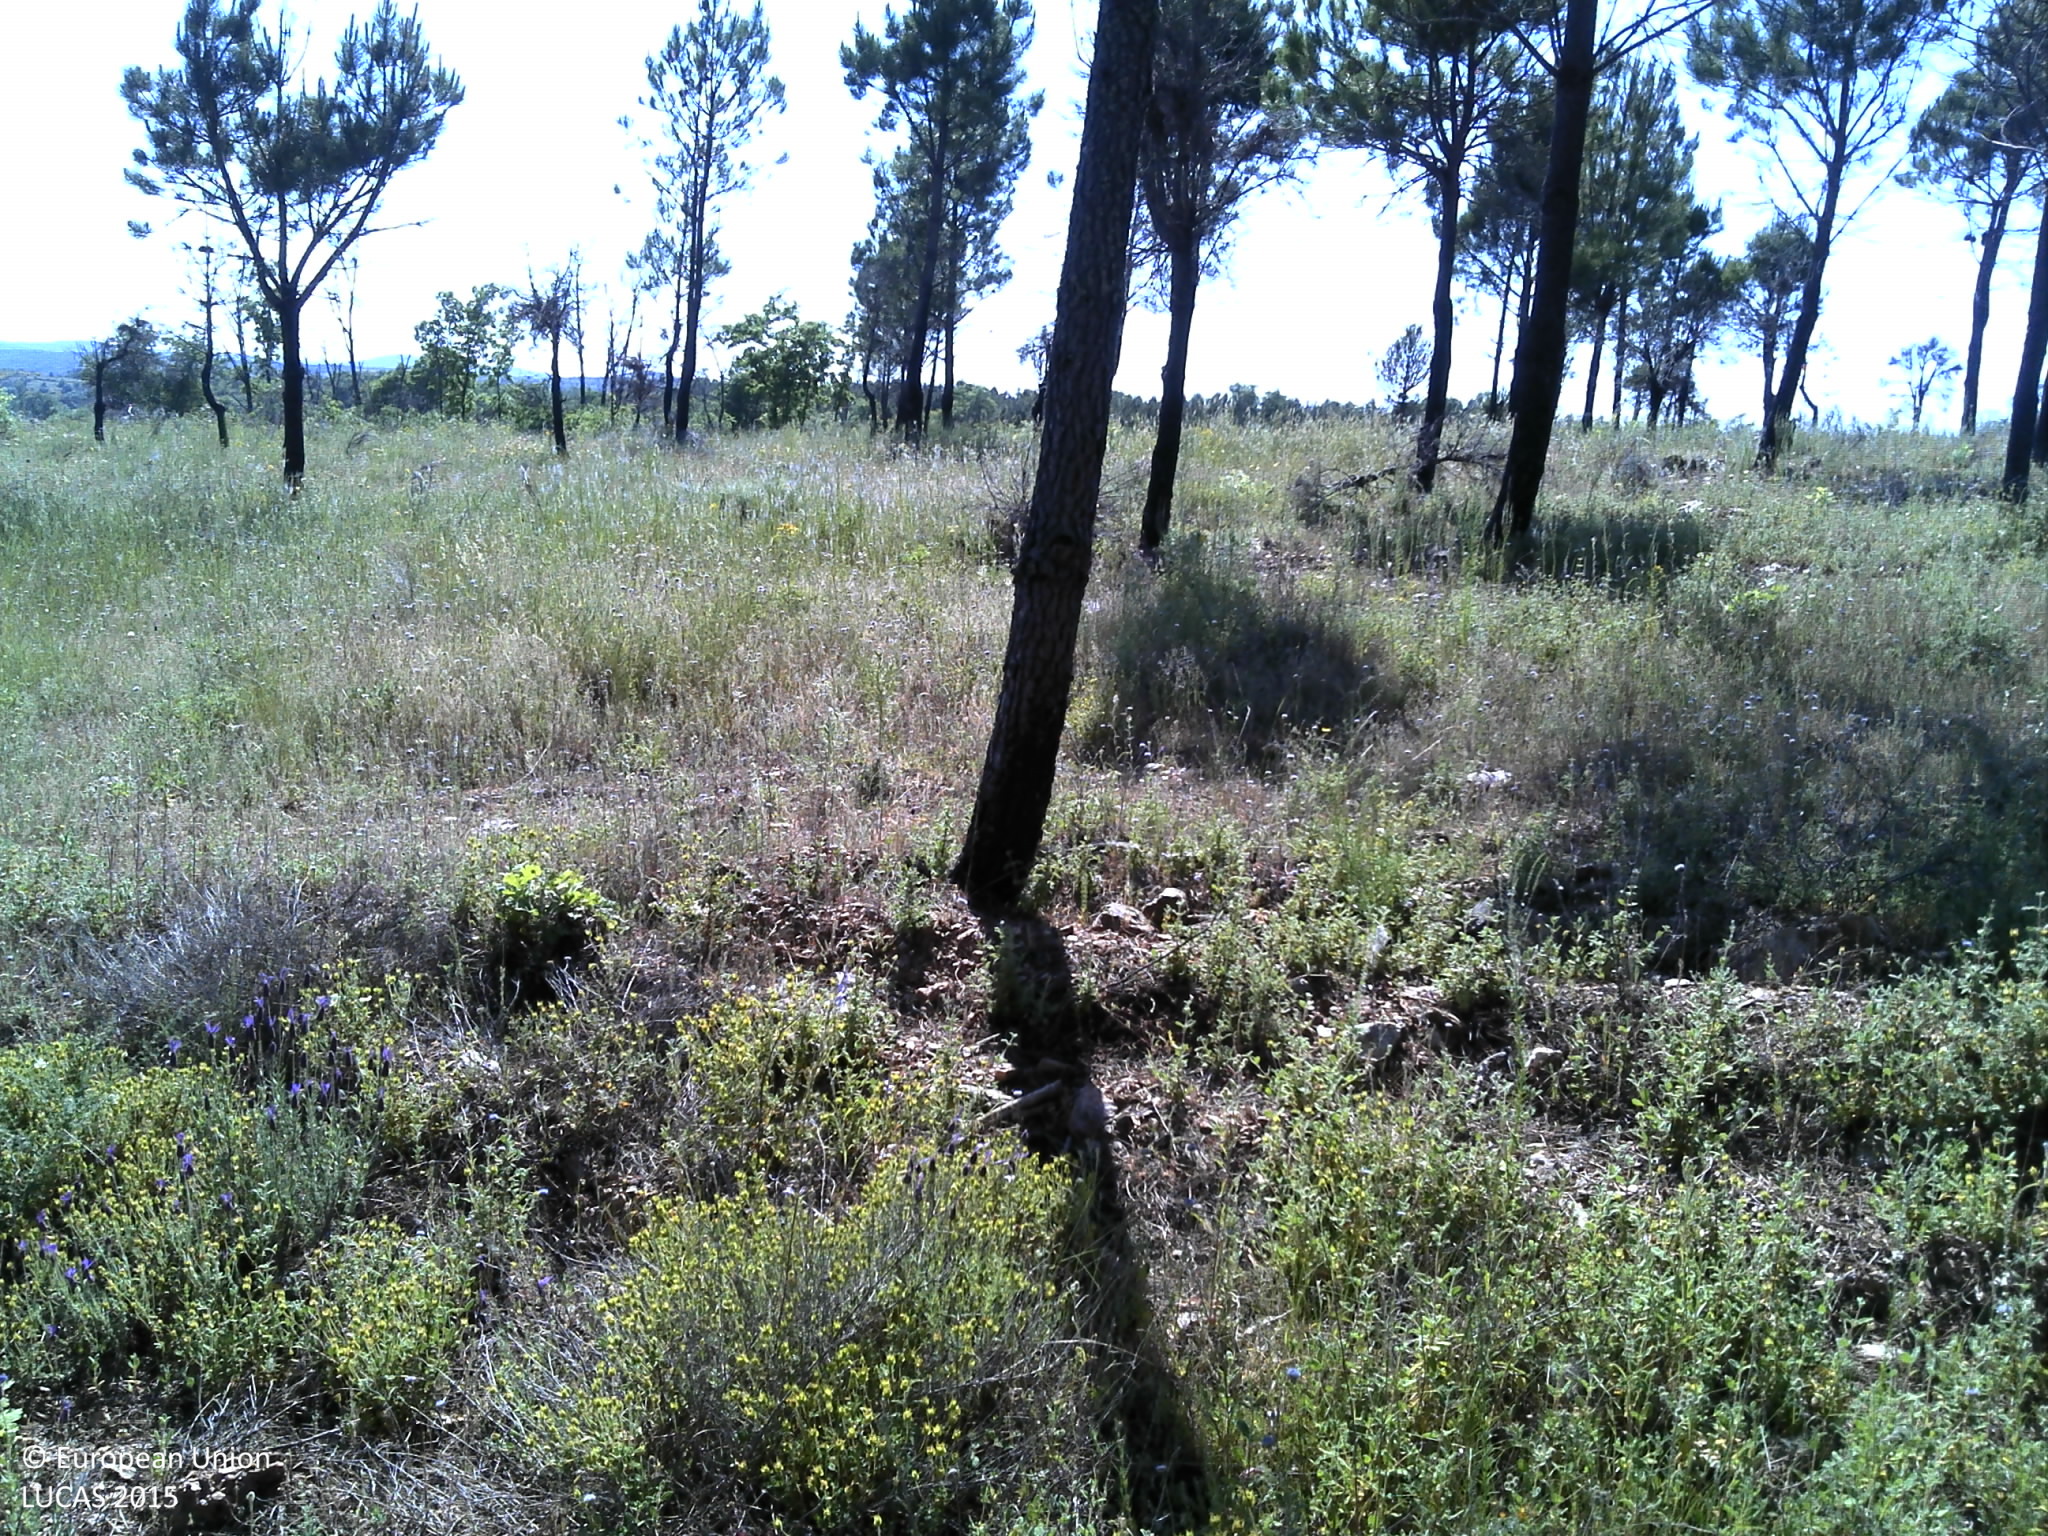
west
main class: Woodland
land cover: Pine dominated coniferous woodland
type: coniferous forest of the mediterranean region
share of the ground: 10 - 25 %
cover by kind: shrubs 50 %, unconsolidated bare surface 30 %, coniferous forest trees 20 %
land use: Forestry
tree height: > 5 m
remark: Burnt area
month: May
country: PT
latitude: 41.6505
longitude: -6.3227
